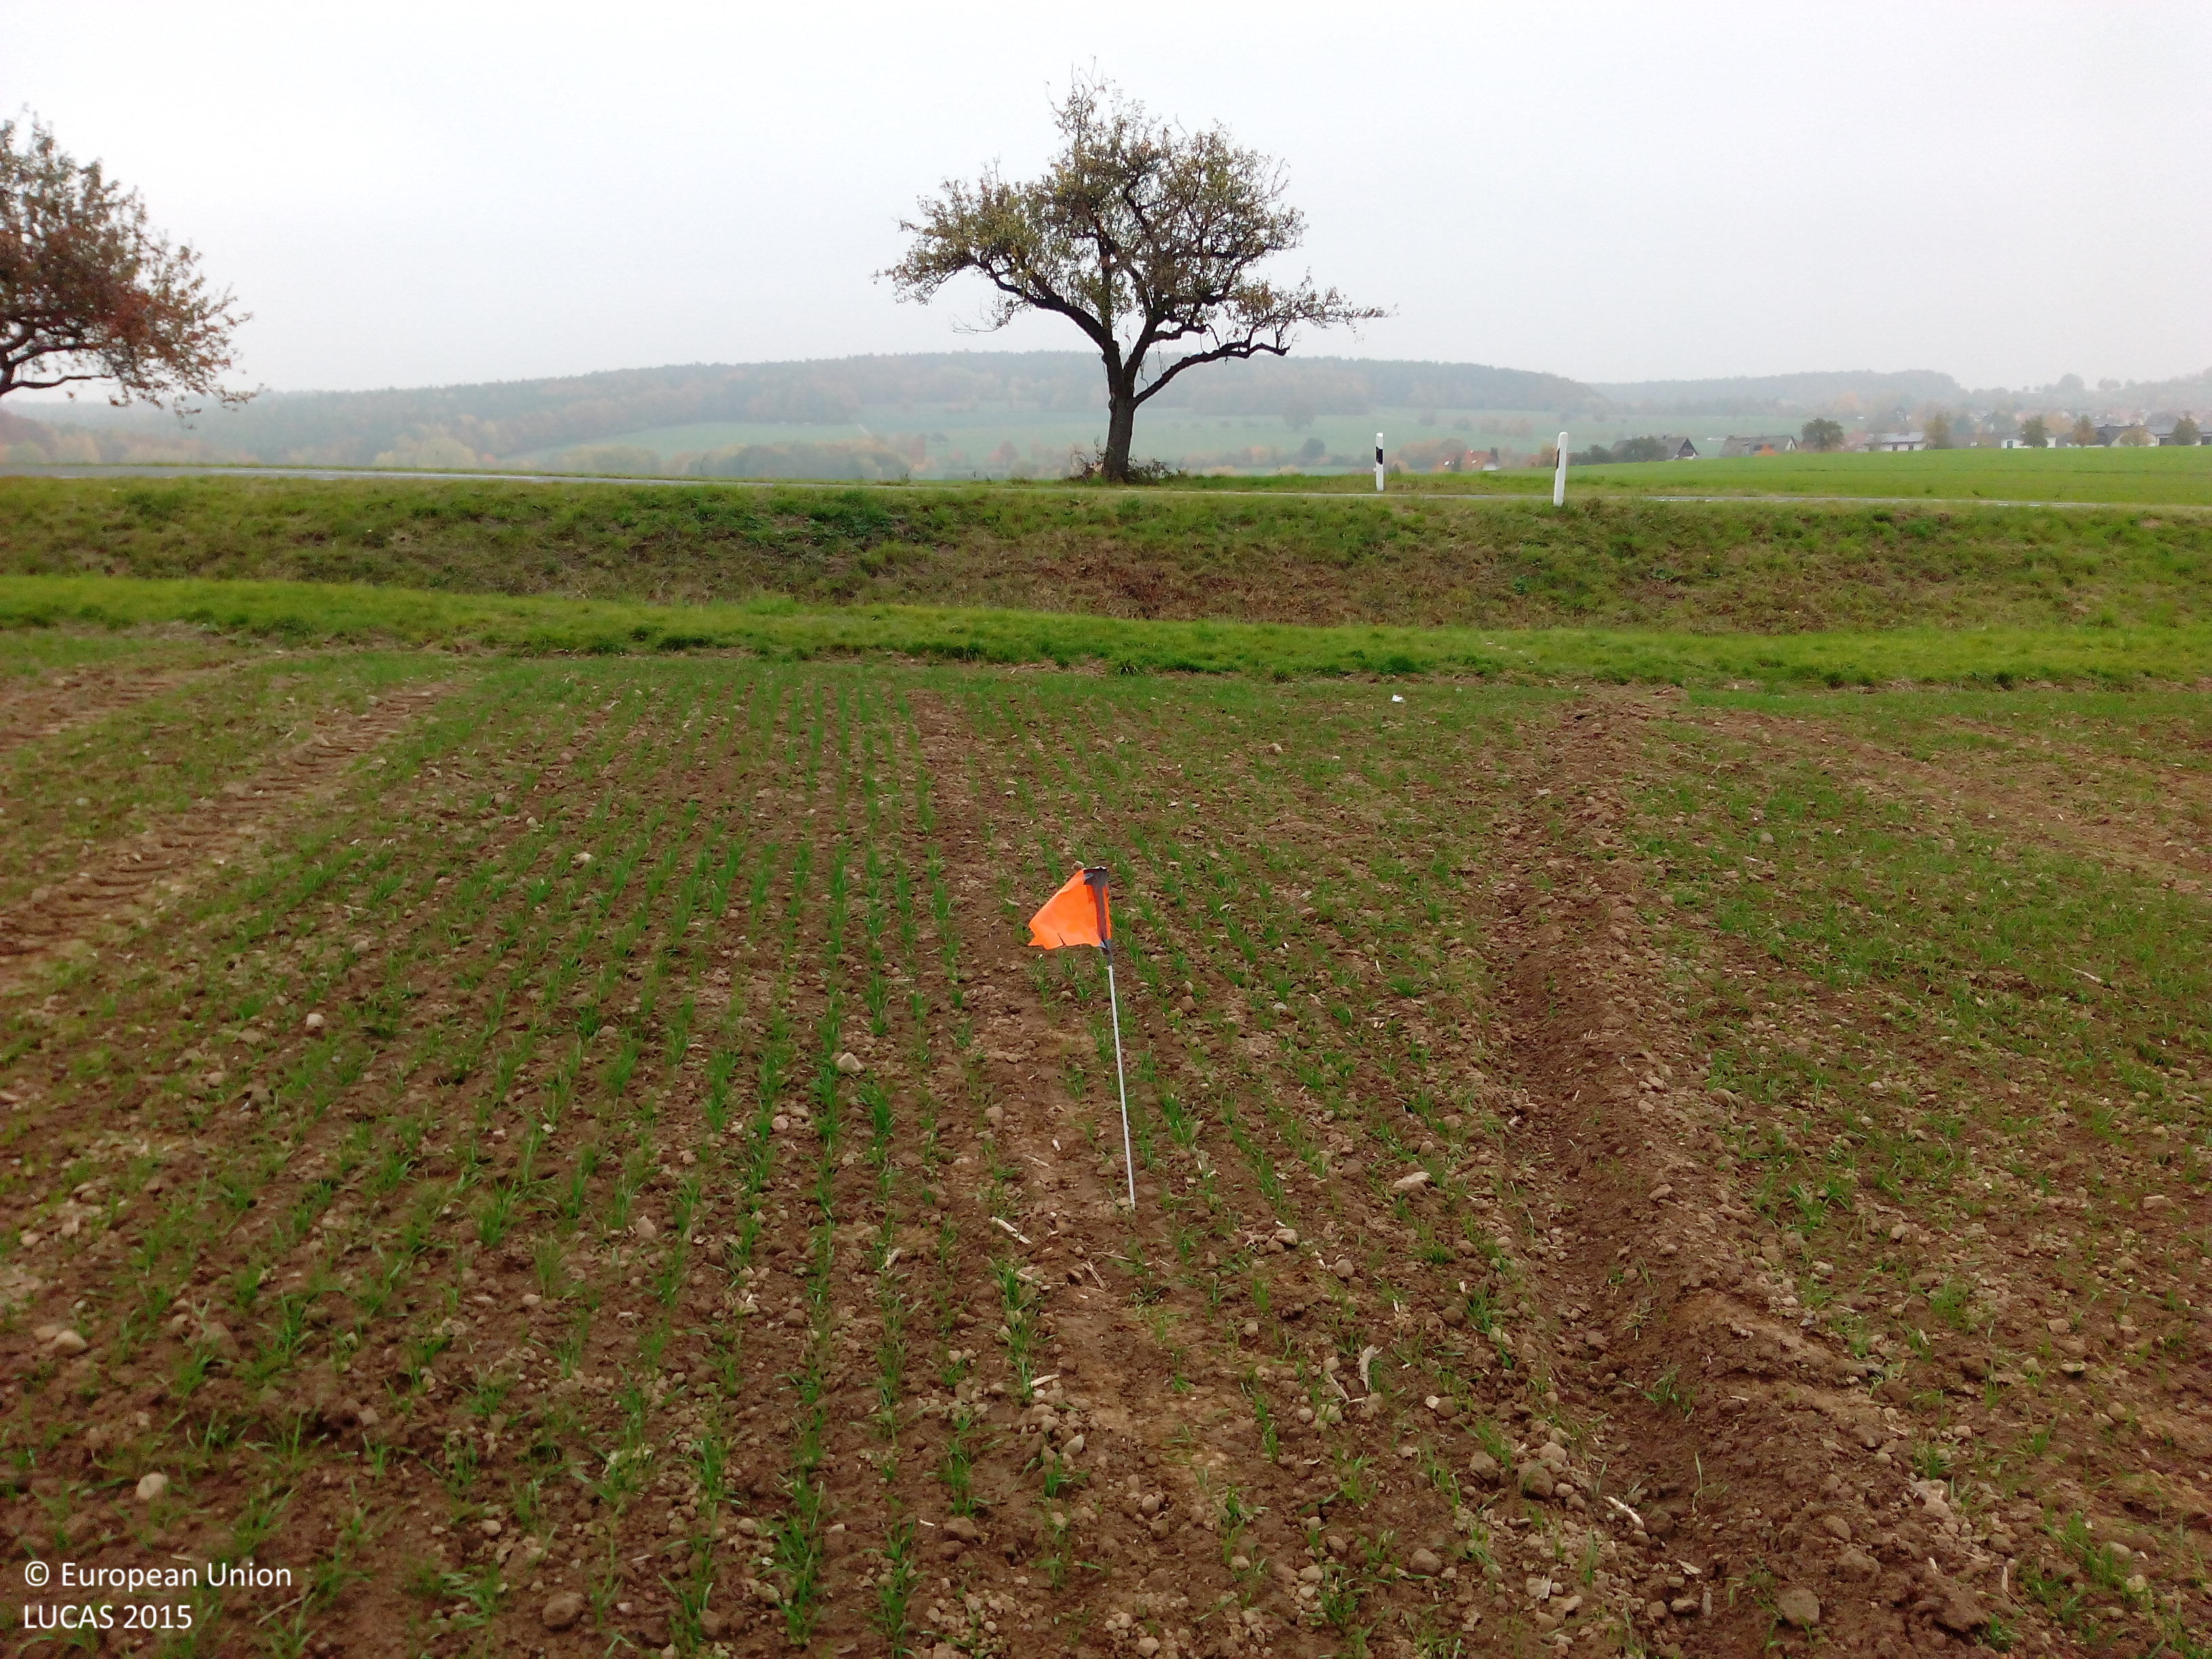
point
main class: Cropland
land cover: Common wheat
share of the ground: < 10 %
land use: Agriculture (excluding fallow land and kitchen gardens)
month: October
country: DE
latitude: 50.2382
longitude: 9.9580
